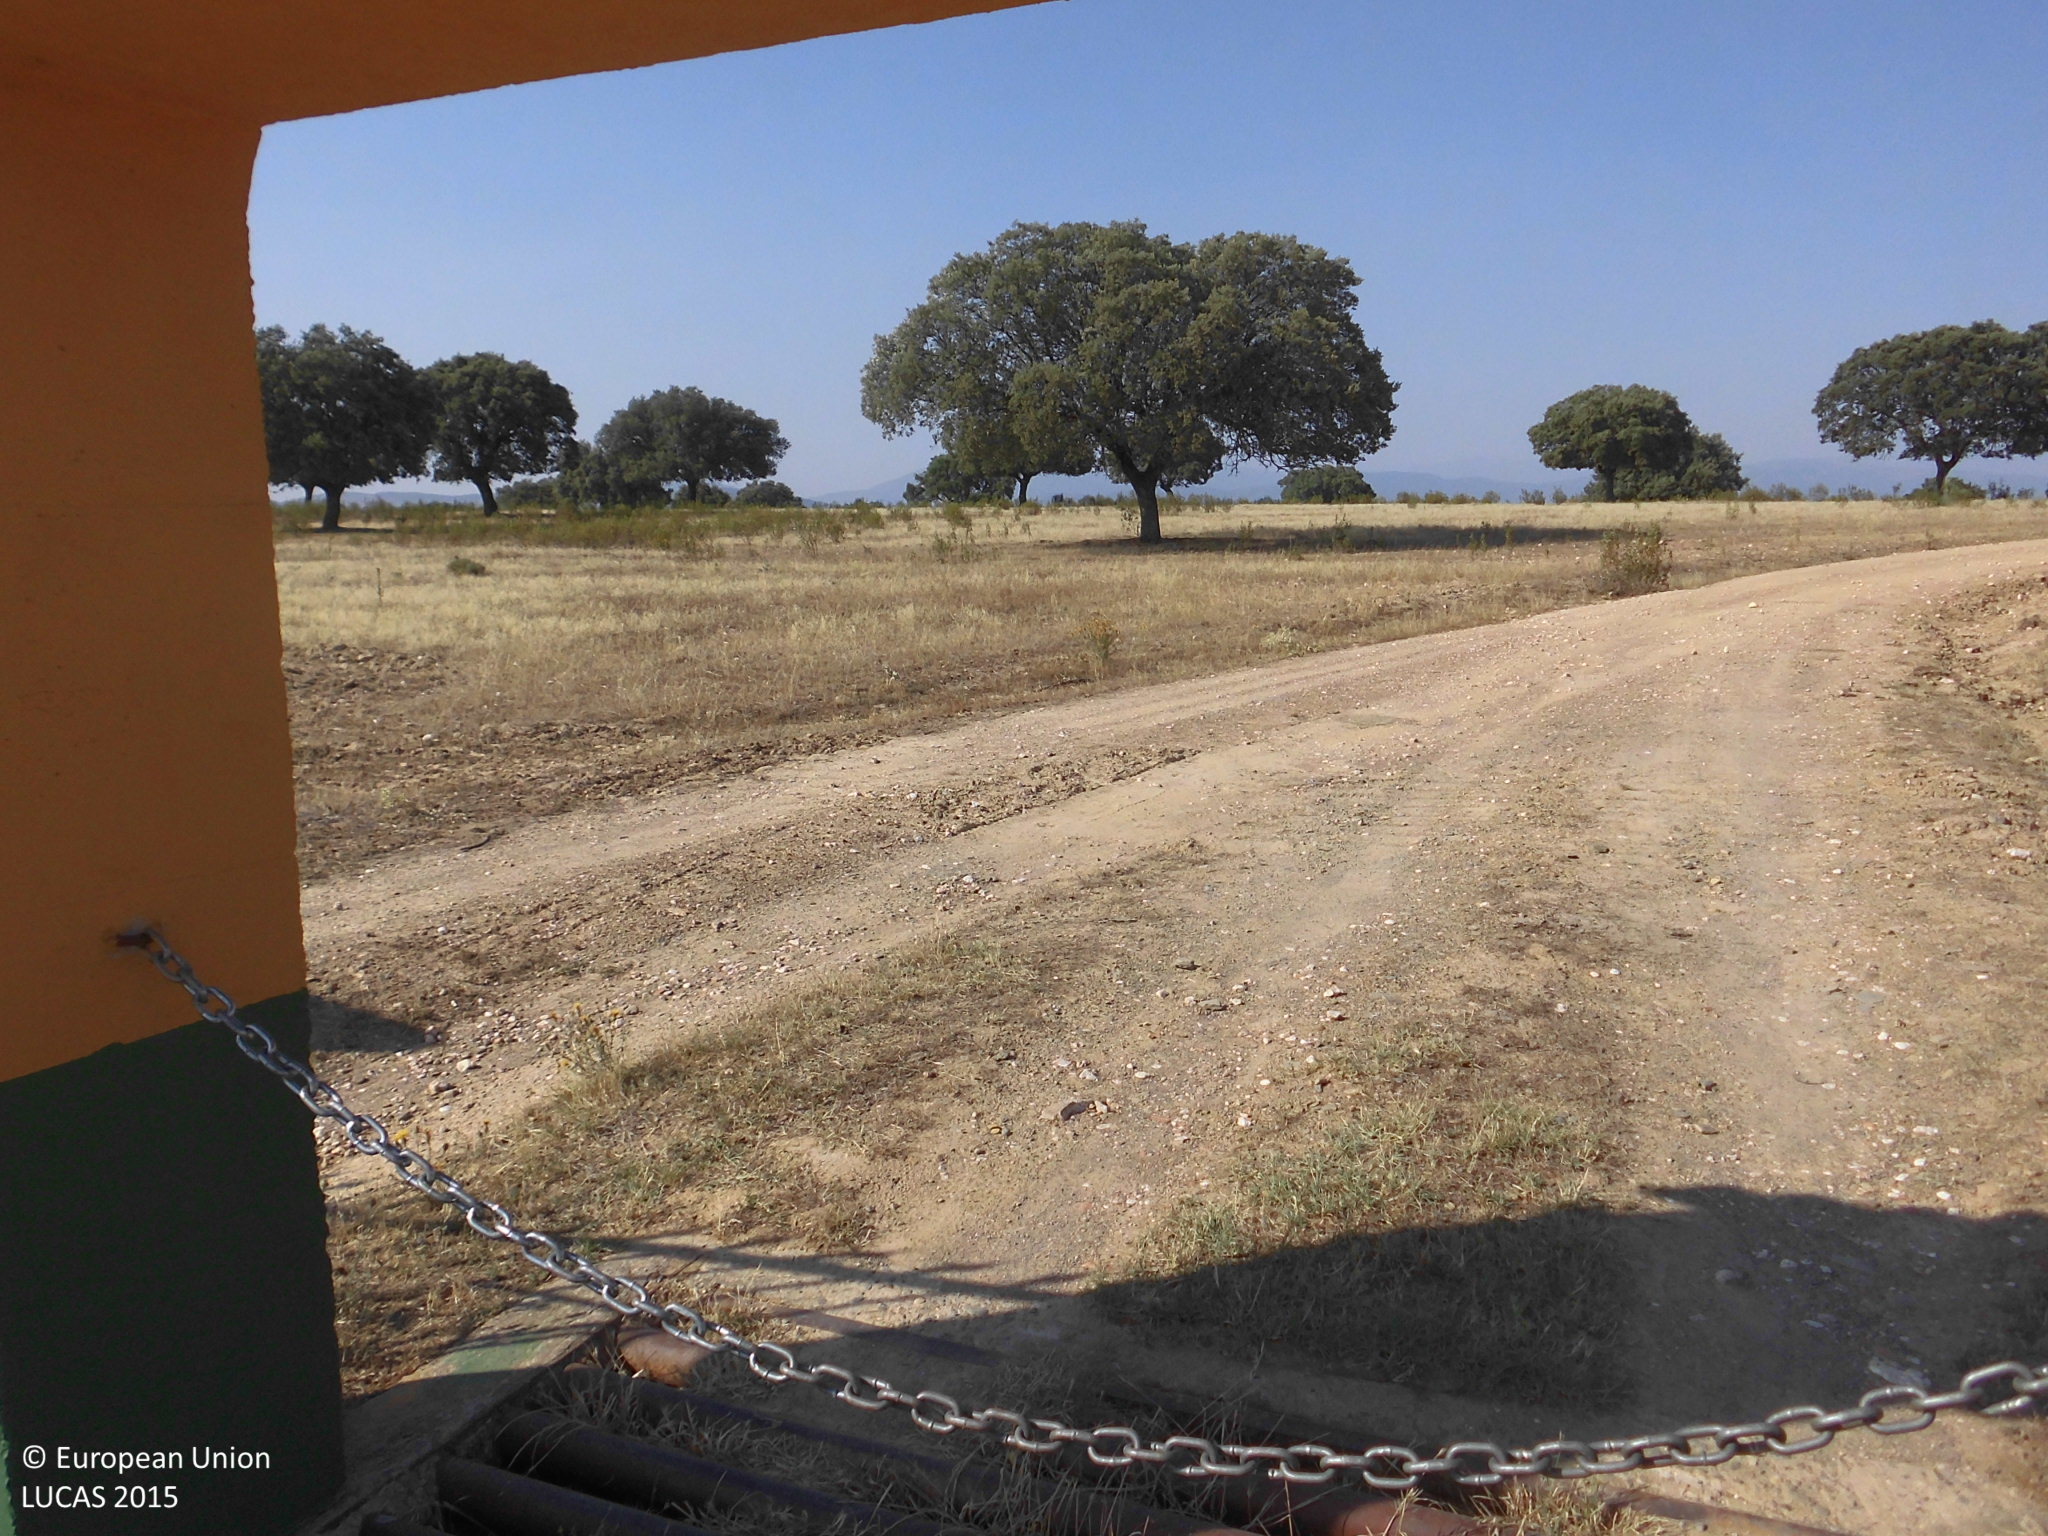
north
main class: Woodland
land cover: Broadleaved woodland
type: broadleaved evergreen forest
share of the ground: 25 - 50 %
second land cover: Shrubland without tree cover
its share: > 75 %
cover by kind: herbaceous plants 50 %, broadleaved forest trees 25 %, shrubs 25 %
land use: Forestry
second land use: Agriculture (excluding fallow land and kitchen gardens)
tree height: > 5 m
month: June
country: ES
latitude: 39.9314
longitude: -6.0416
